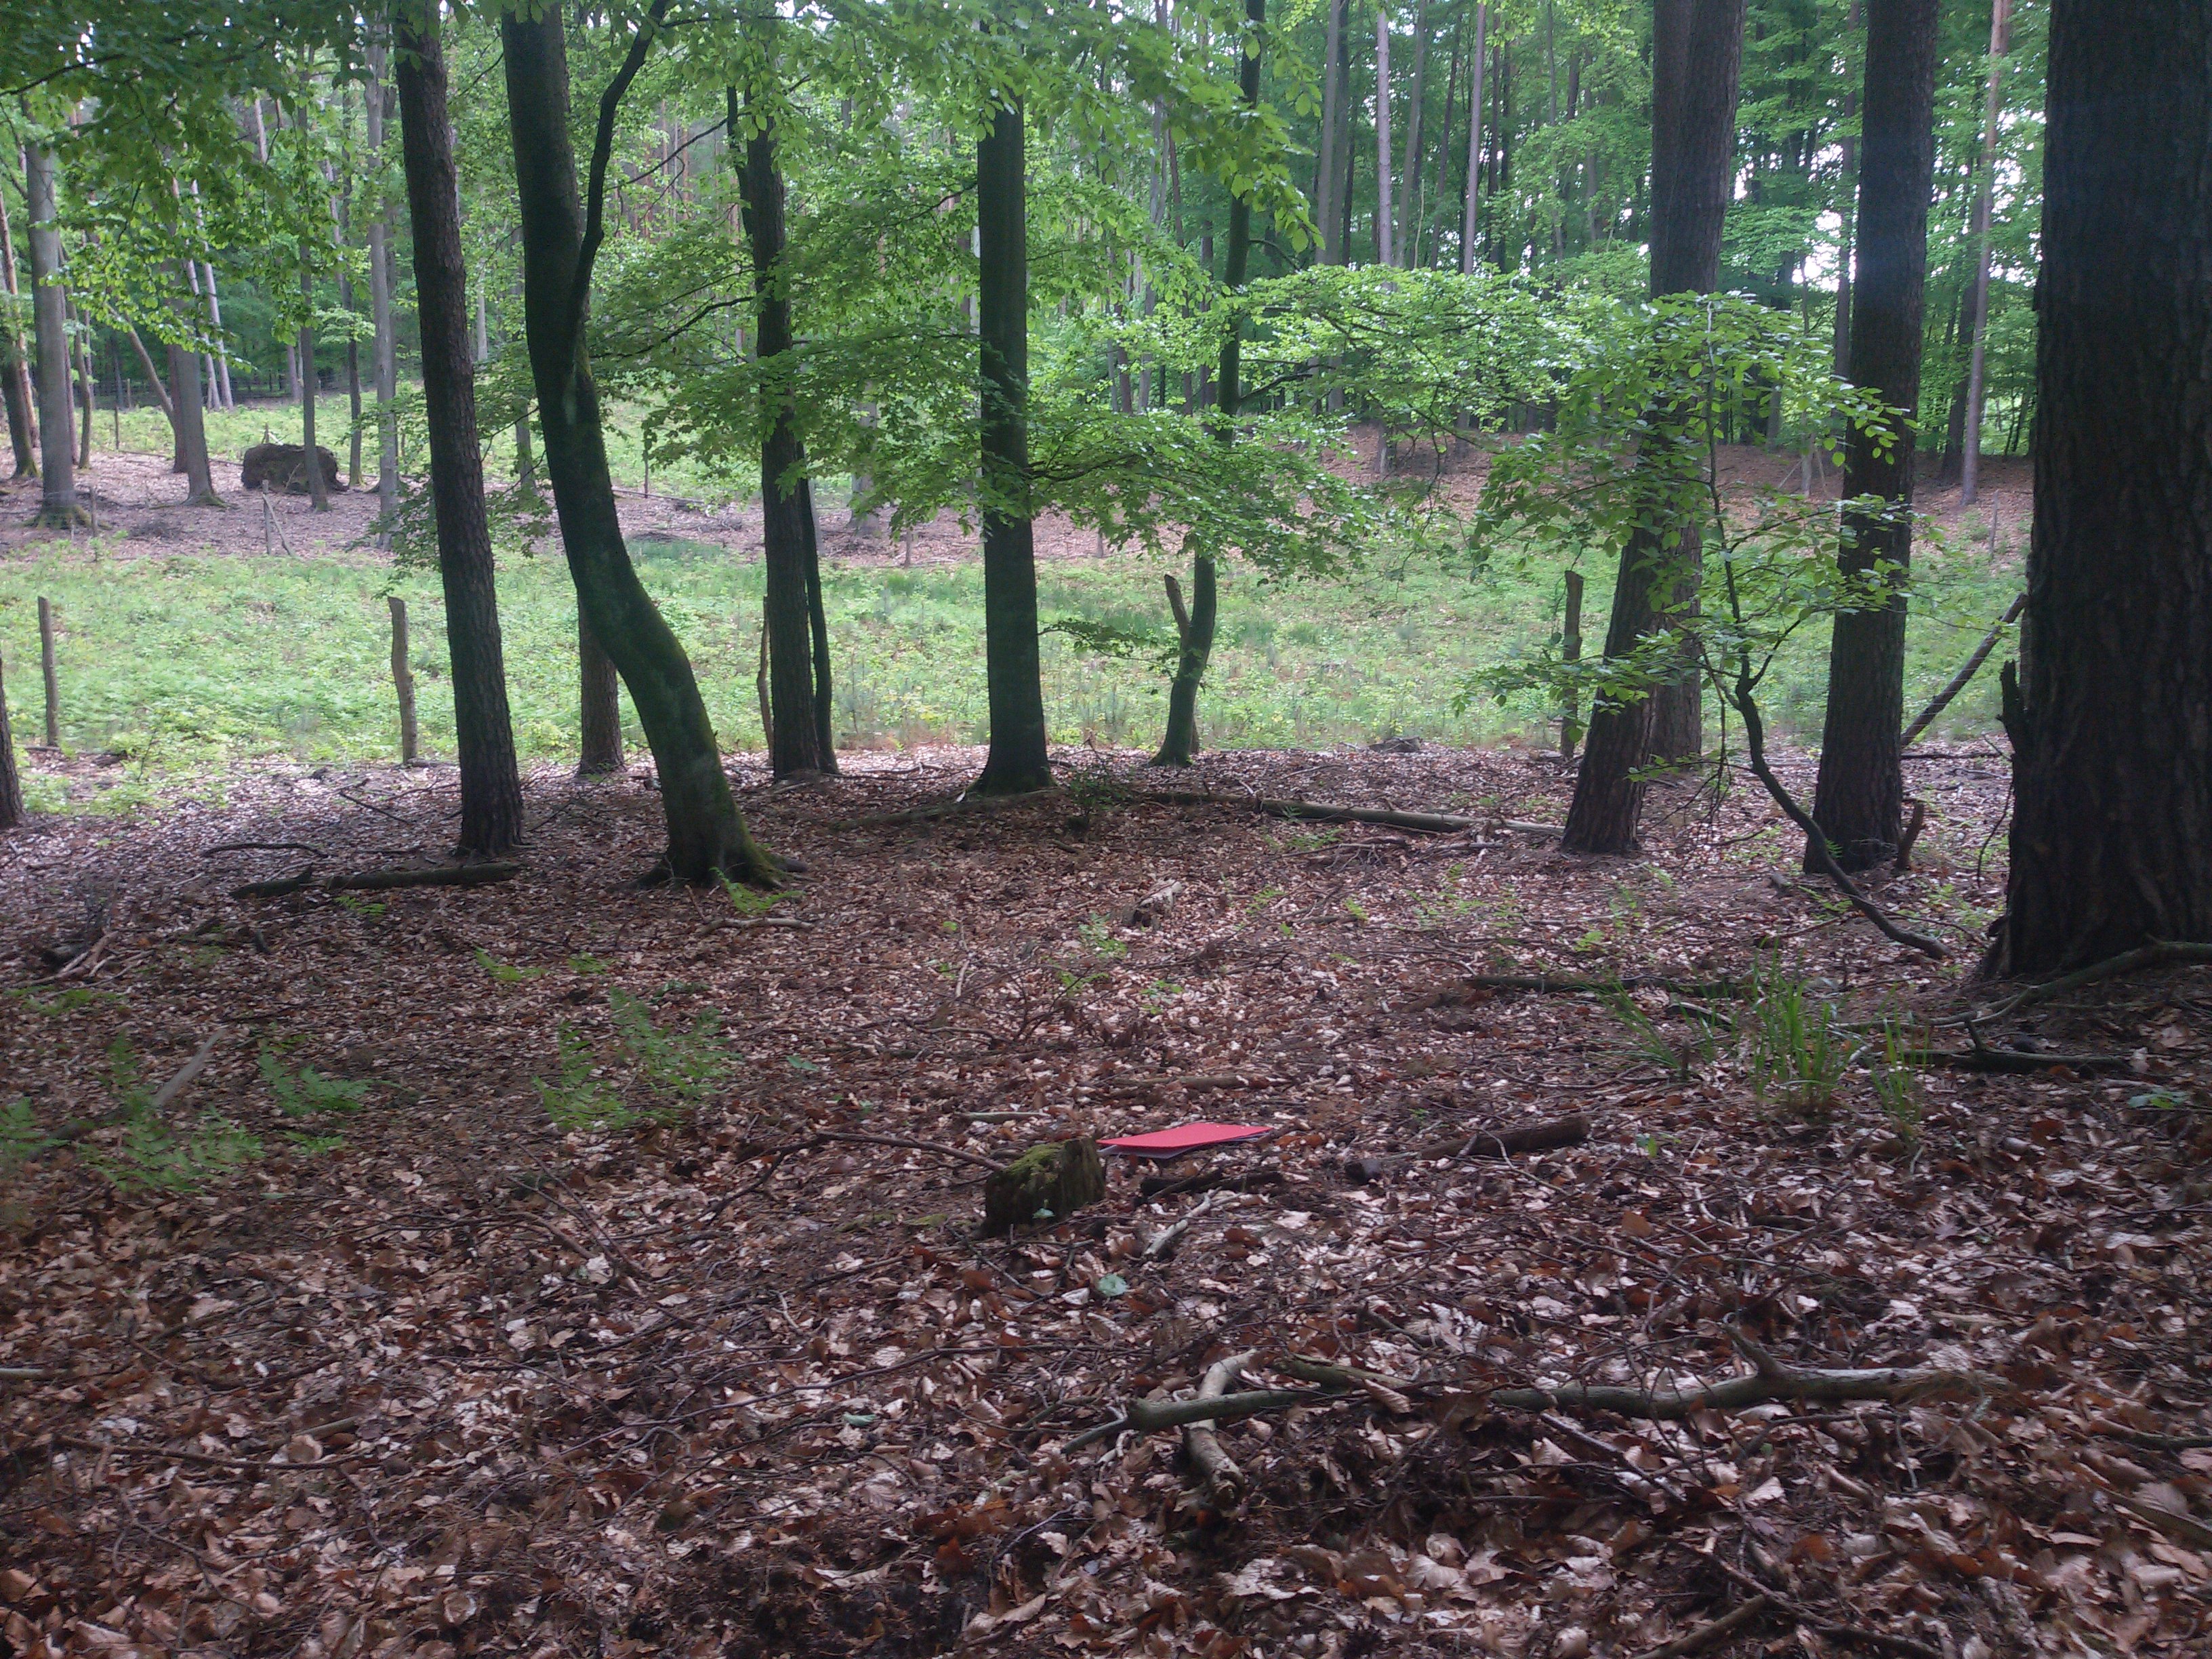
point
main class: Woodland
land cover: Pine dominated mixed woodland
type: hemiboreal forest and nemoral coniferous forest and mixed broadleaved-coniferous forest
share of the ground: > 75 %
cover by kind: coniferous forest trees 60 %, broadleaved forest trees 40 %
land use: Forestry
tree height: > 5 m
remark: Nursery
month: May
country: PL
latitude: 53.6492
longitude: 14.3123
